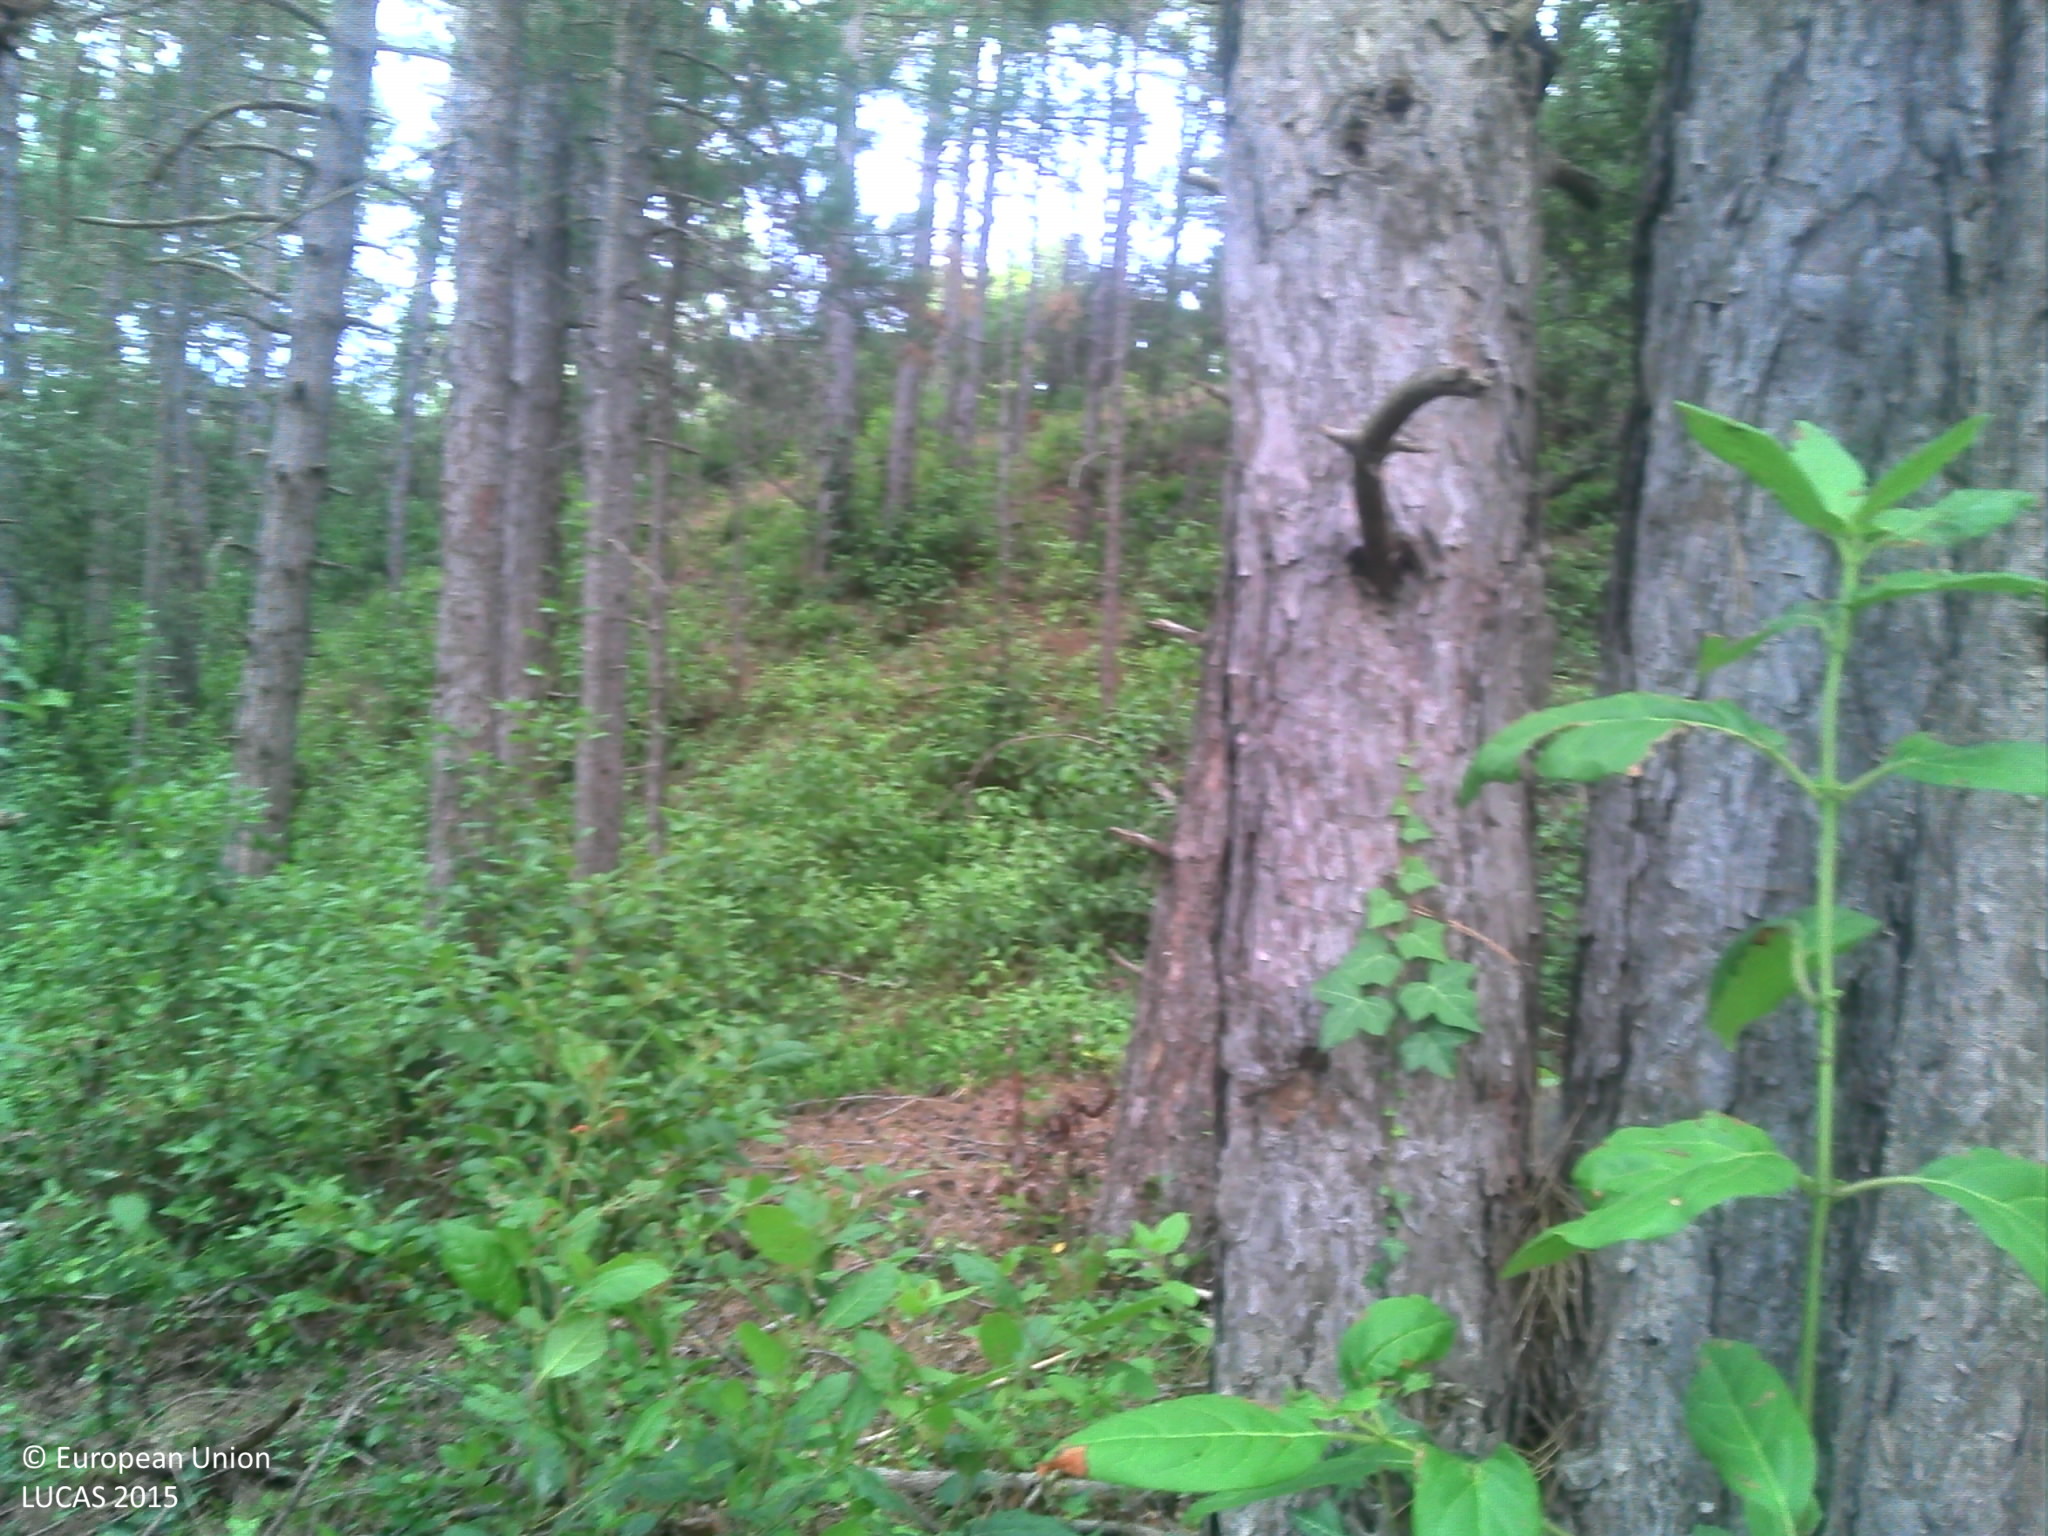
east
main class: Woodland
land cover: Pine dominated coniferous woodland
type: coniferous forest of the mediterranean region
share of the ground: > 75 %
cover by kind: coniferous forest trees 90 %, herbaceous plants 10 %
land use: Semi-natural and natural areas not in use
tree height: > 5 m
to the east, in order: Pine dominated coniferous woodland; Artificial constructions in urban areas; Broadleaved woodland; Floriculture and ornamental plants; Grass margins; Paved roads, cycling and walking lanes; Other bare soil
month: July
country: FR
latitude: 44.3918
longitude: 4.6215
